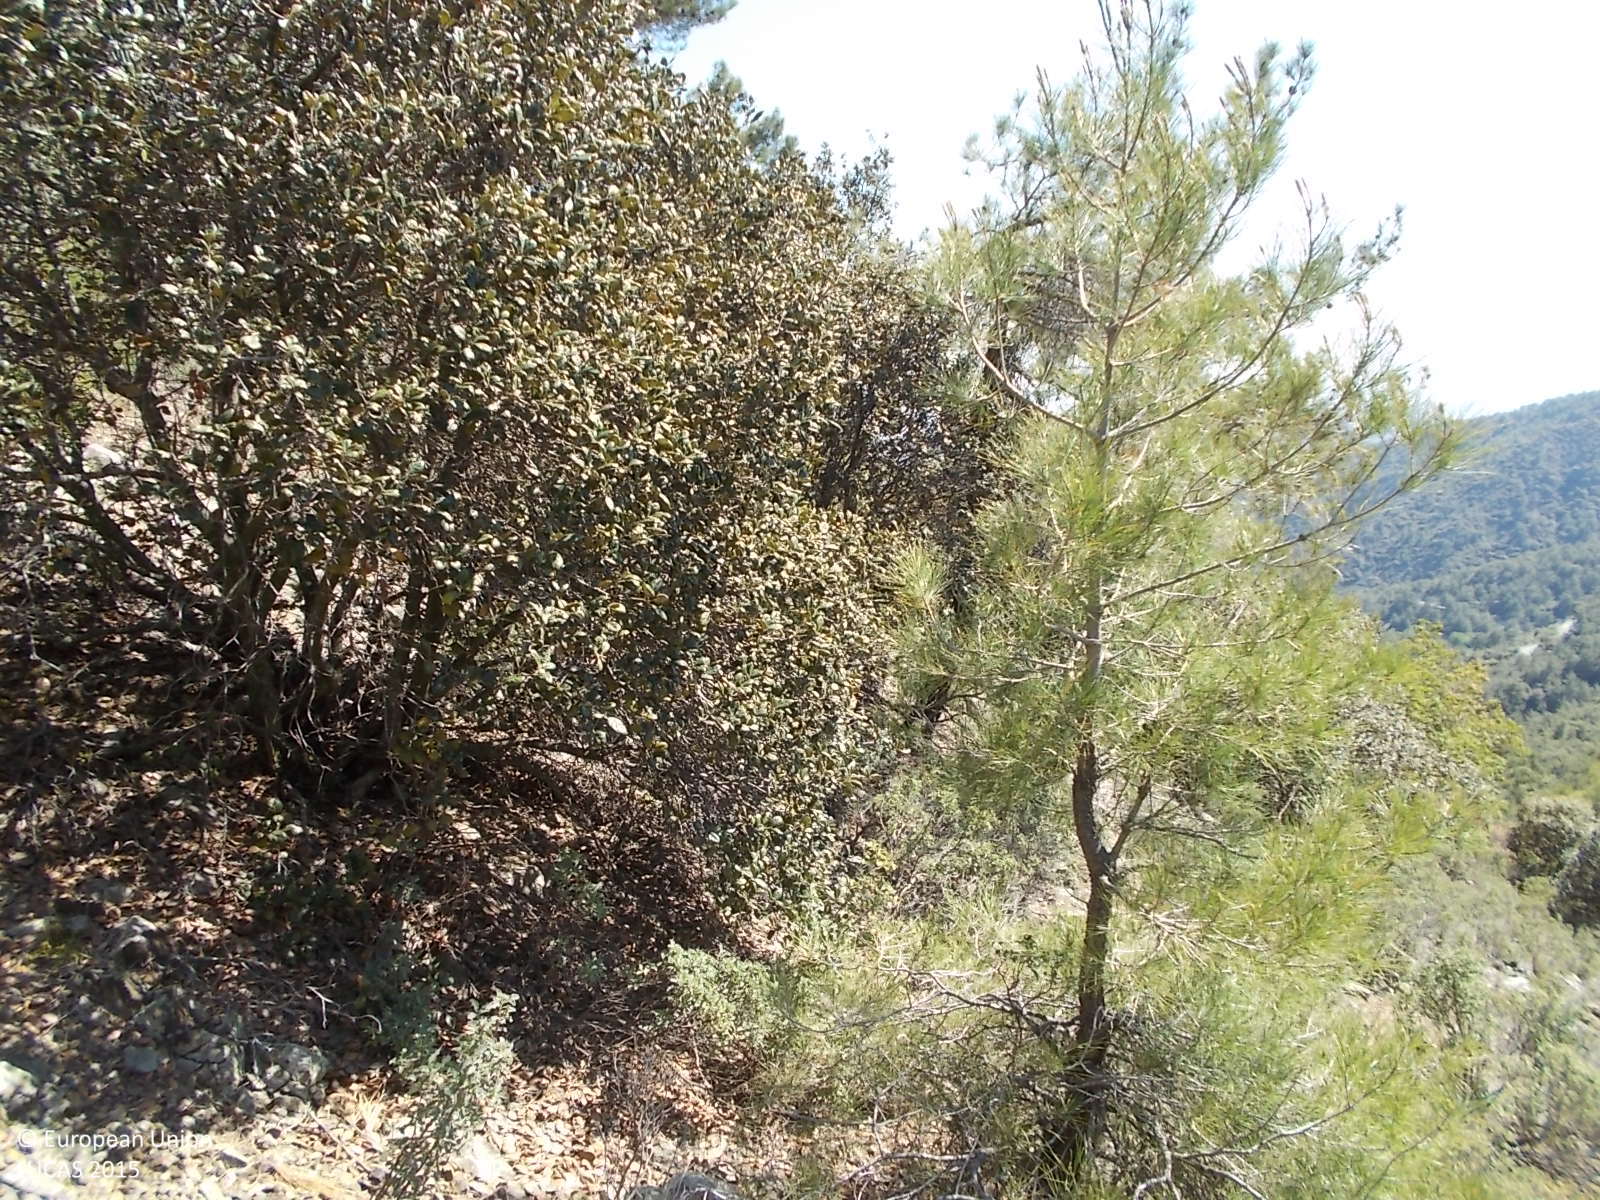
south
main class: Shrubland
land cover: Shrubland with sparse tree cover
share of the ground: > 75 %
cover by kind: shrubs 95 %, broadleaved forest trees 5 %
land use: Semi-natural and natural areas not in use
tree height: > 5 m
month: May
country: CY
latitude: 34.8929
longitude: 33.0532
